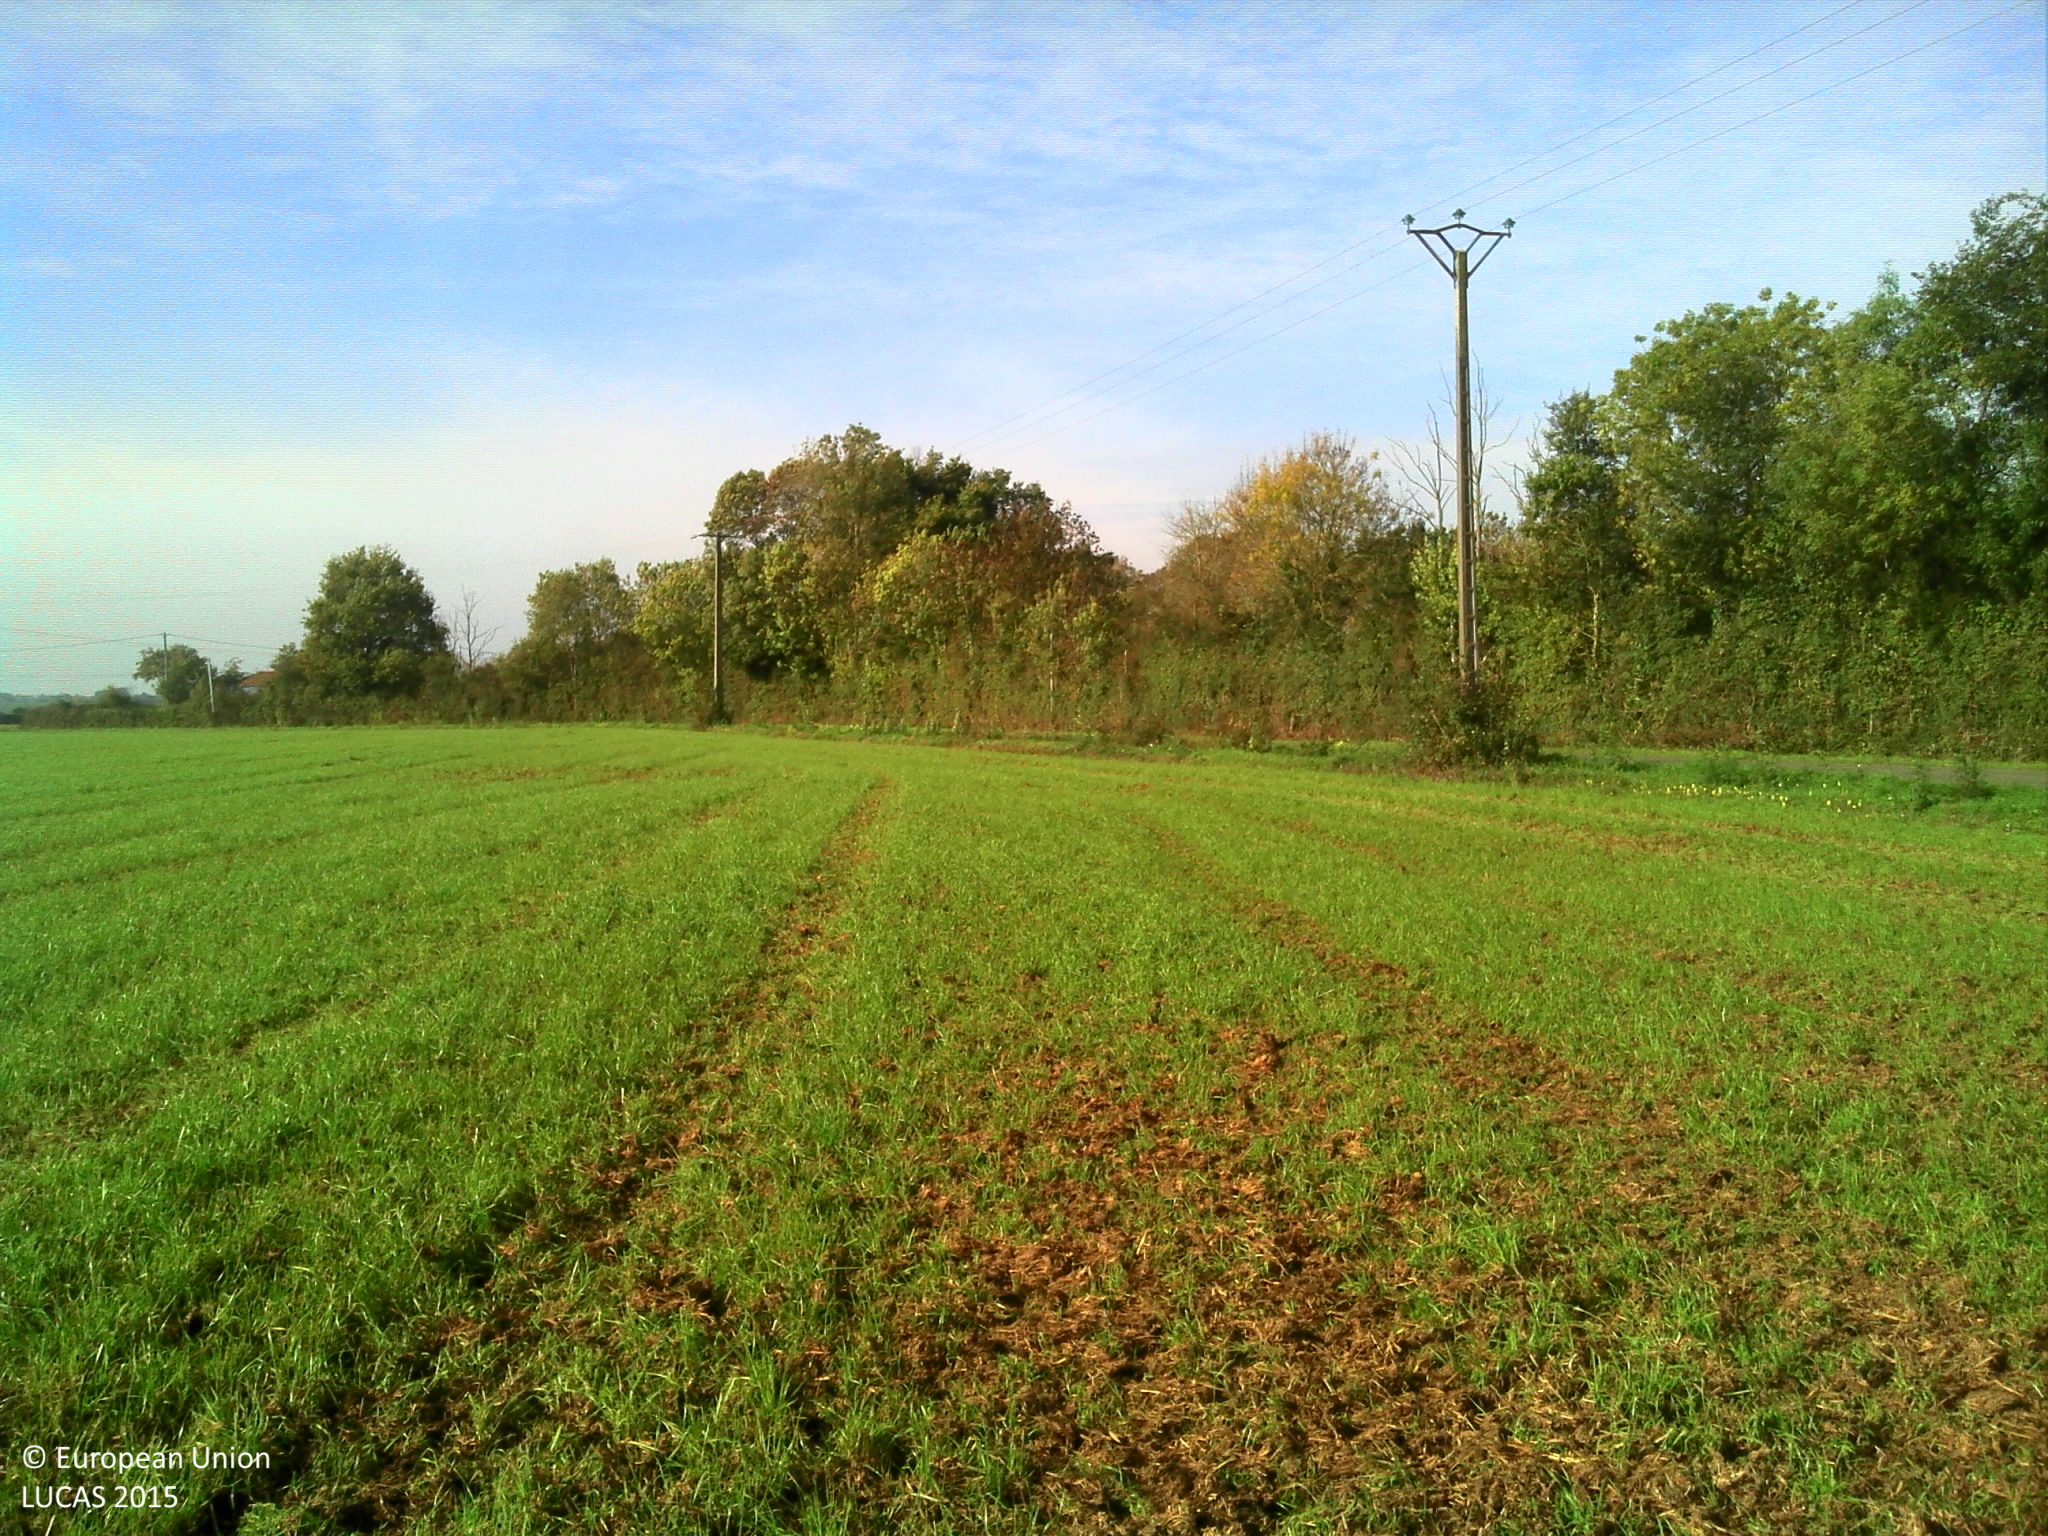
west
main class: Cropland
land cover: Temporary grasslands
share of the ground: > 75 %
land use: Agriculture (excluding fallow land and kitchen gardens)
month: October
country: FR
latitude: 47.1862
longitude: -0.9485
